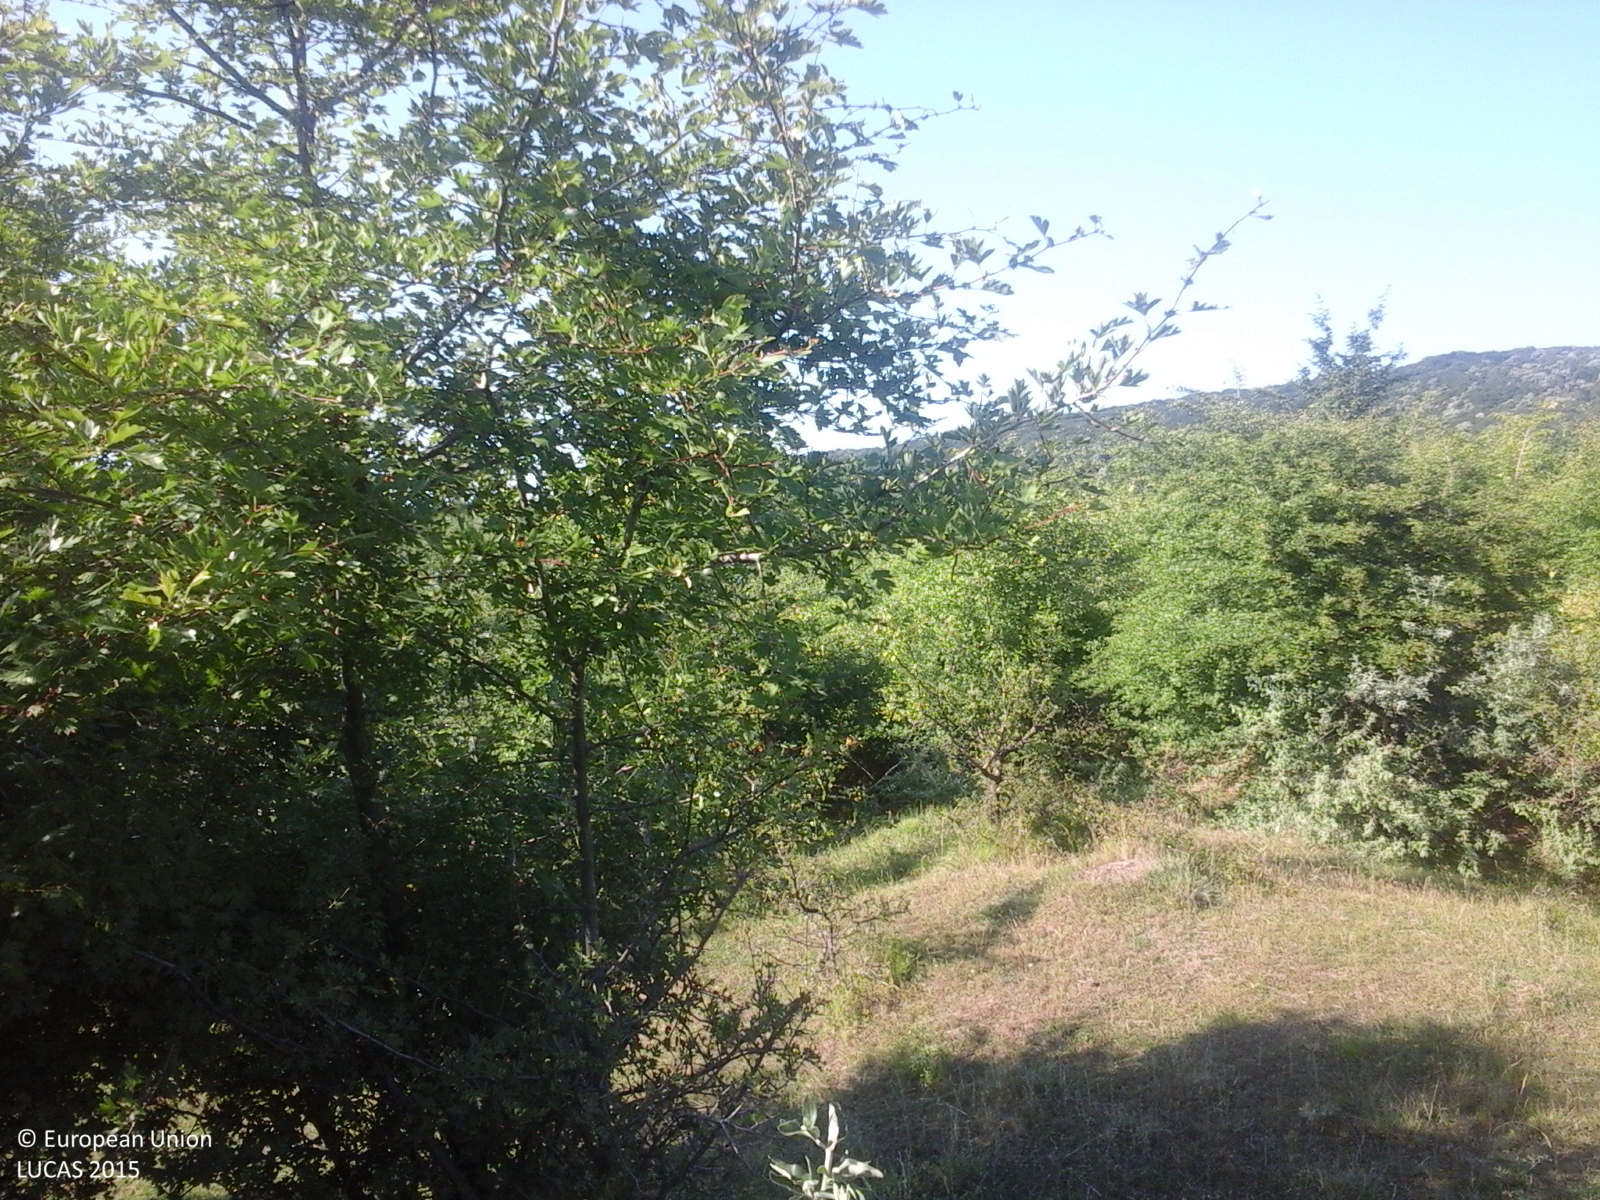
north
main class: Shrubland
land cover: Shrubland with sparse tree cover
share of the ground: > 75 %
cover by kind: herbaceous plants 85 %, shrubs 10 %, broadleaved forest trees 5 %
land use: Agriculture (excluding fallow land and kitchen gardens)
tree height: < 5 m
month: June
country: RO
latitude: 46.9990
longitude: 27.3509
